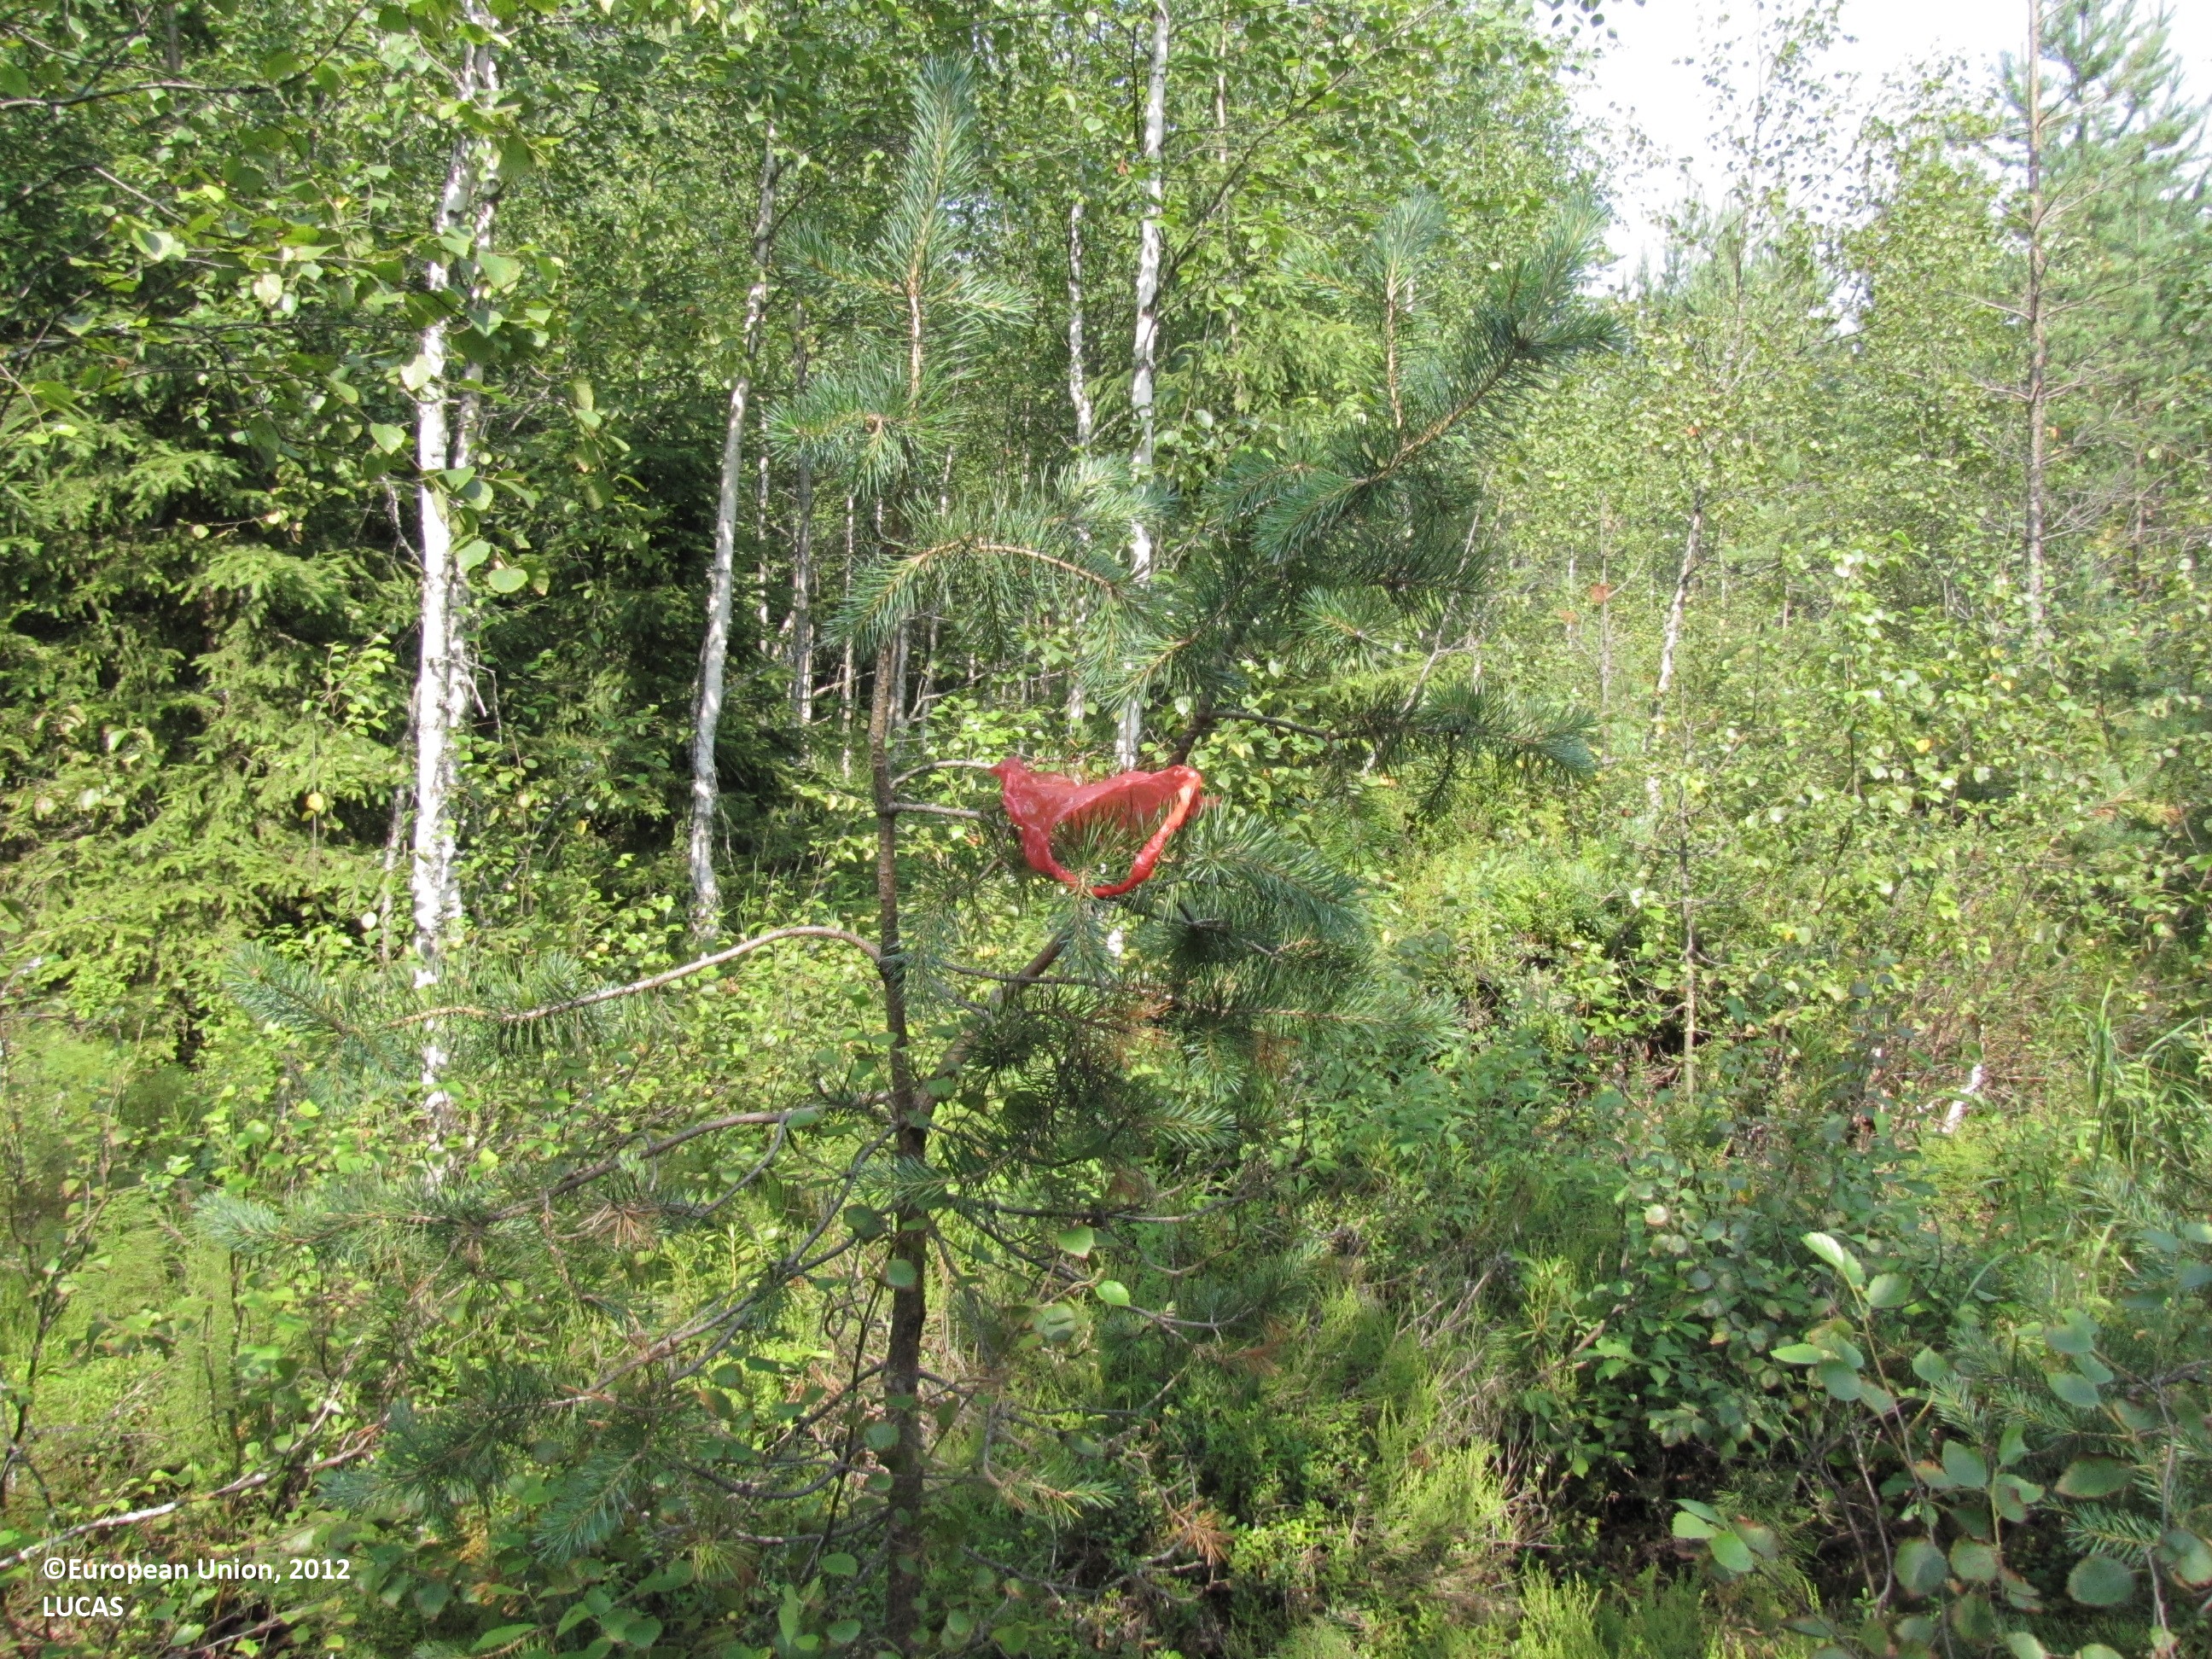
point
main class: Woodland
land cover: Other mixed woodland
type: boreal forest
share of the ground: 50 - 75 %
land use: Forestry
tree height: > 5 m
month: July
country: FI
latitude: 62.0280
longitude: 23.1996
